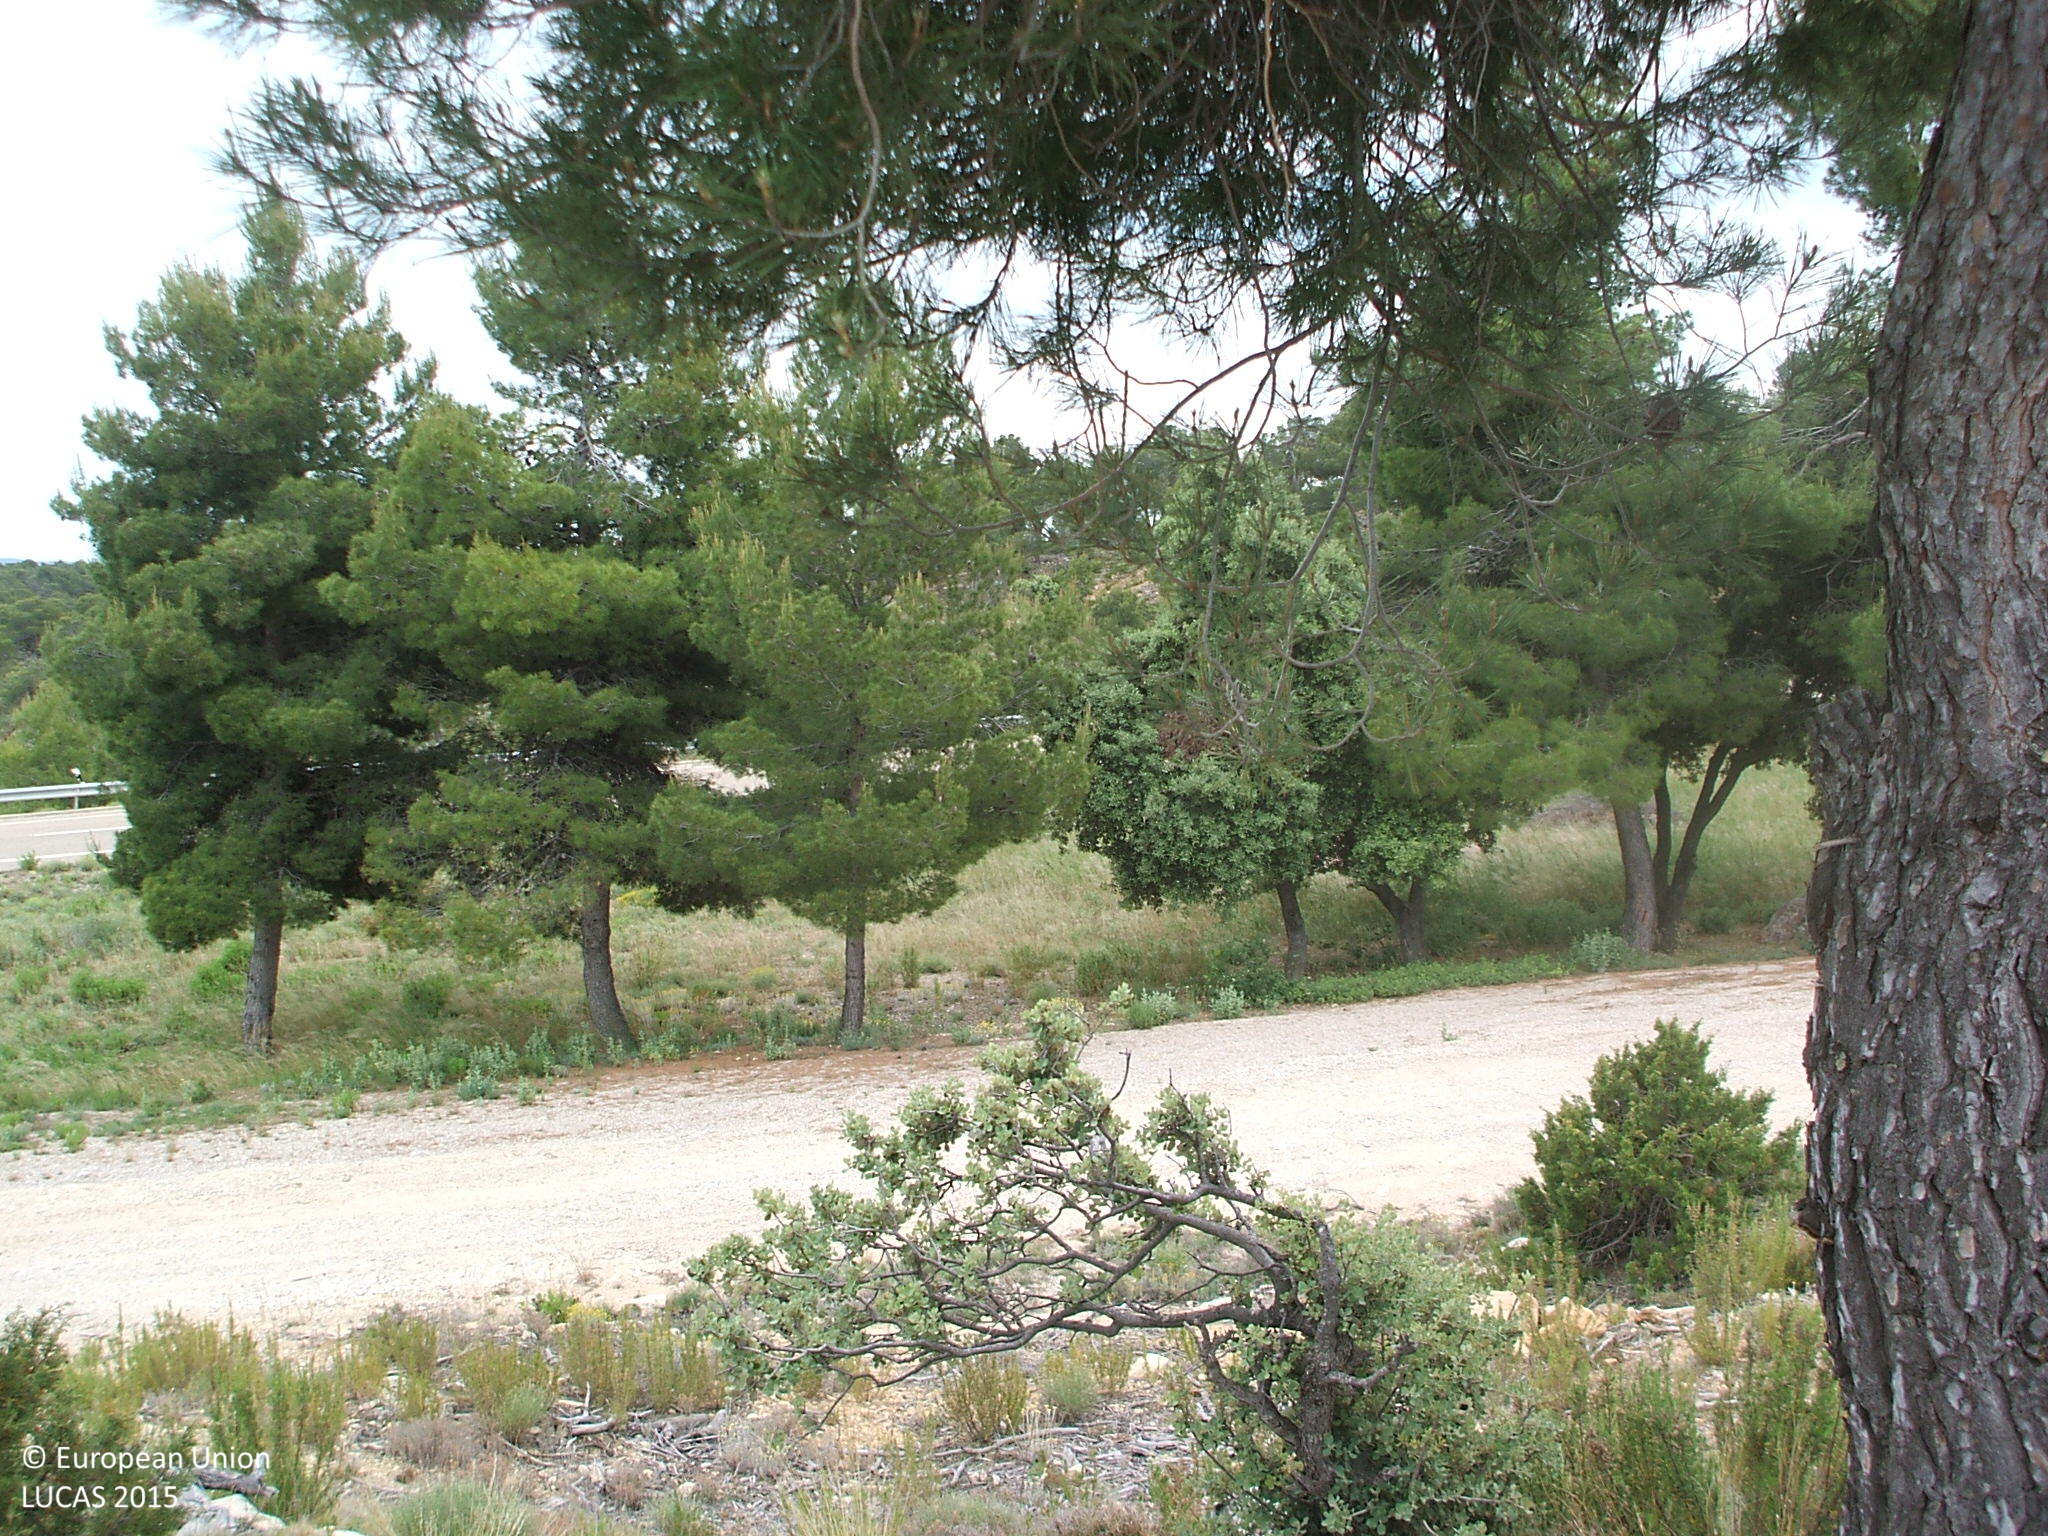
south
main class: Woodland
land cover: Pine dominated mixed woodland
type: coniferous forest of the mediterranean region
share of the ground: > 75 %
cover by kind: coniferous forest trees 75 %, broadleaved forest trees 25 %
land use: Semi-natural and natural areas not in use
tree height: > 5 m
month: June
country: ES
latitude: 40.8627
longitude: -0.0342
